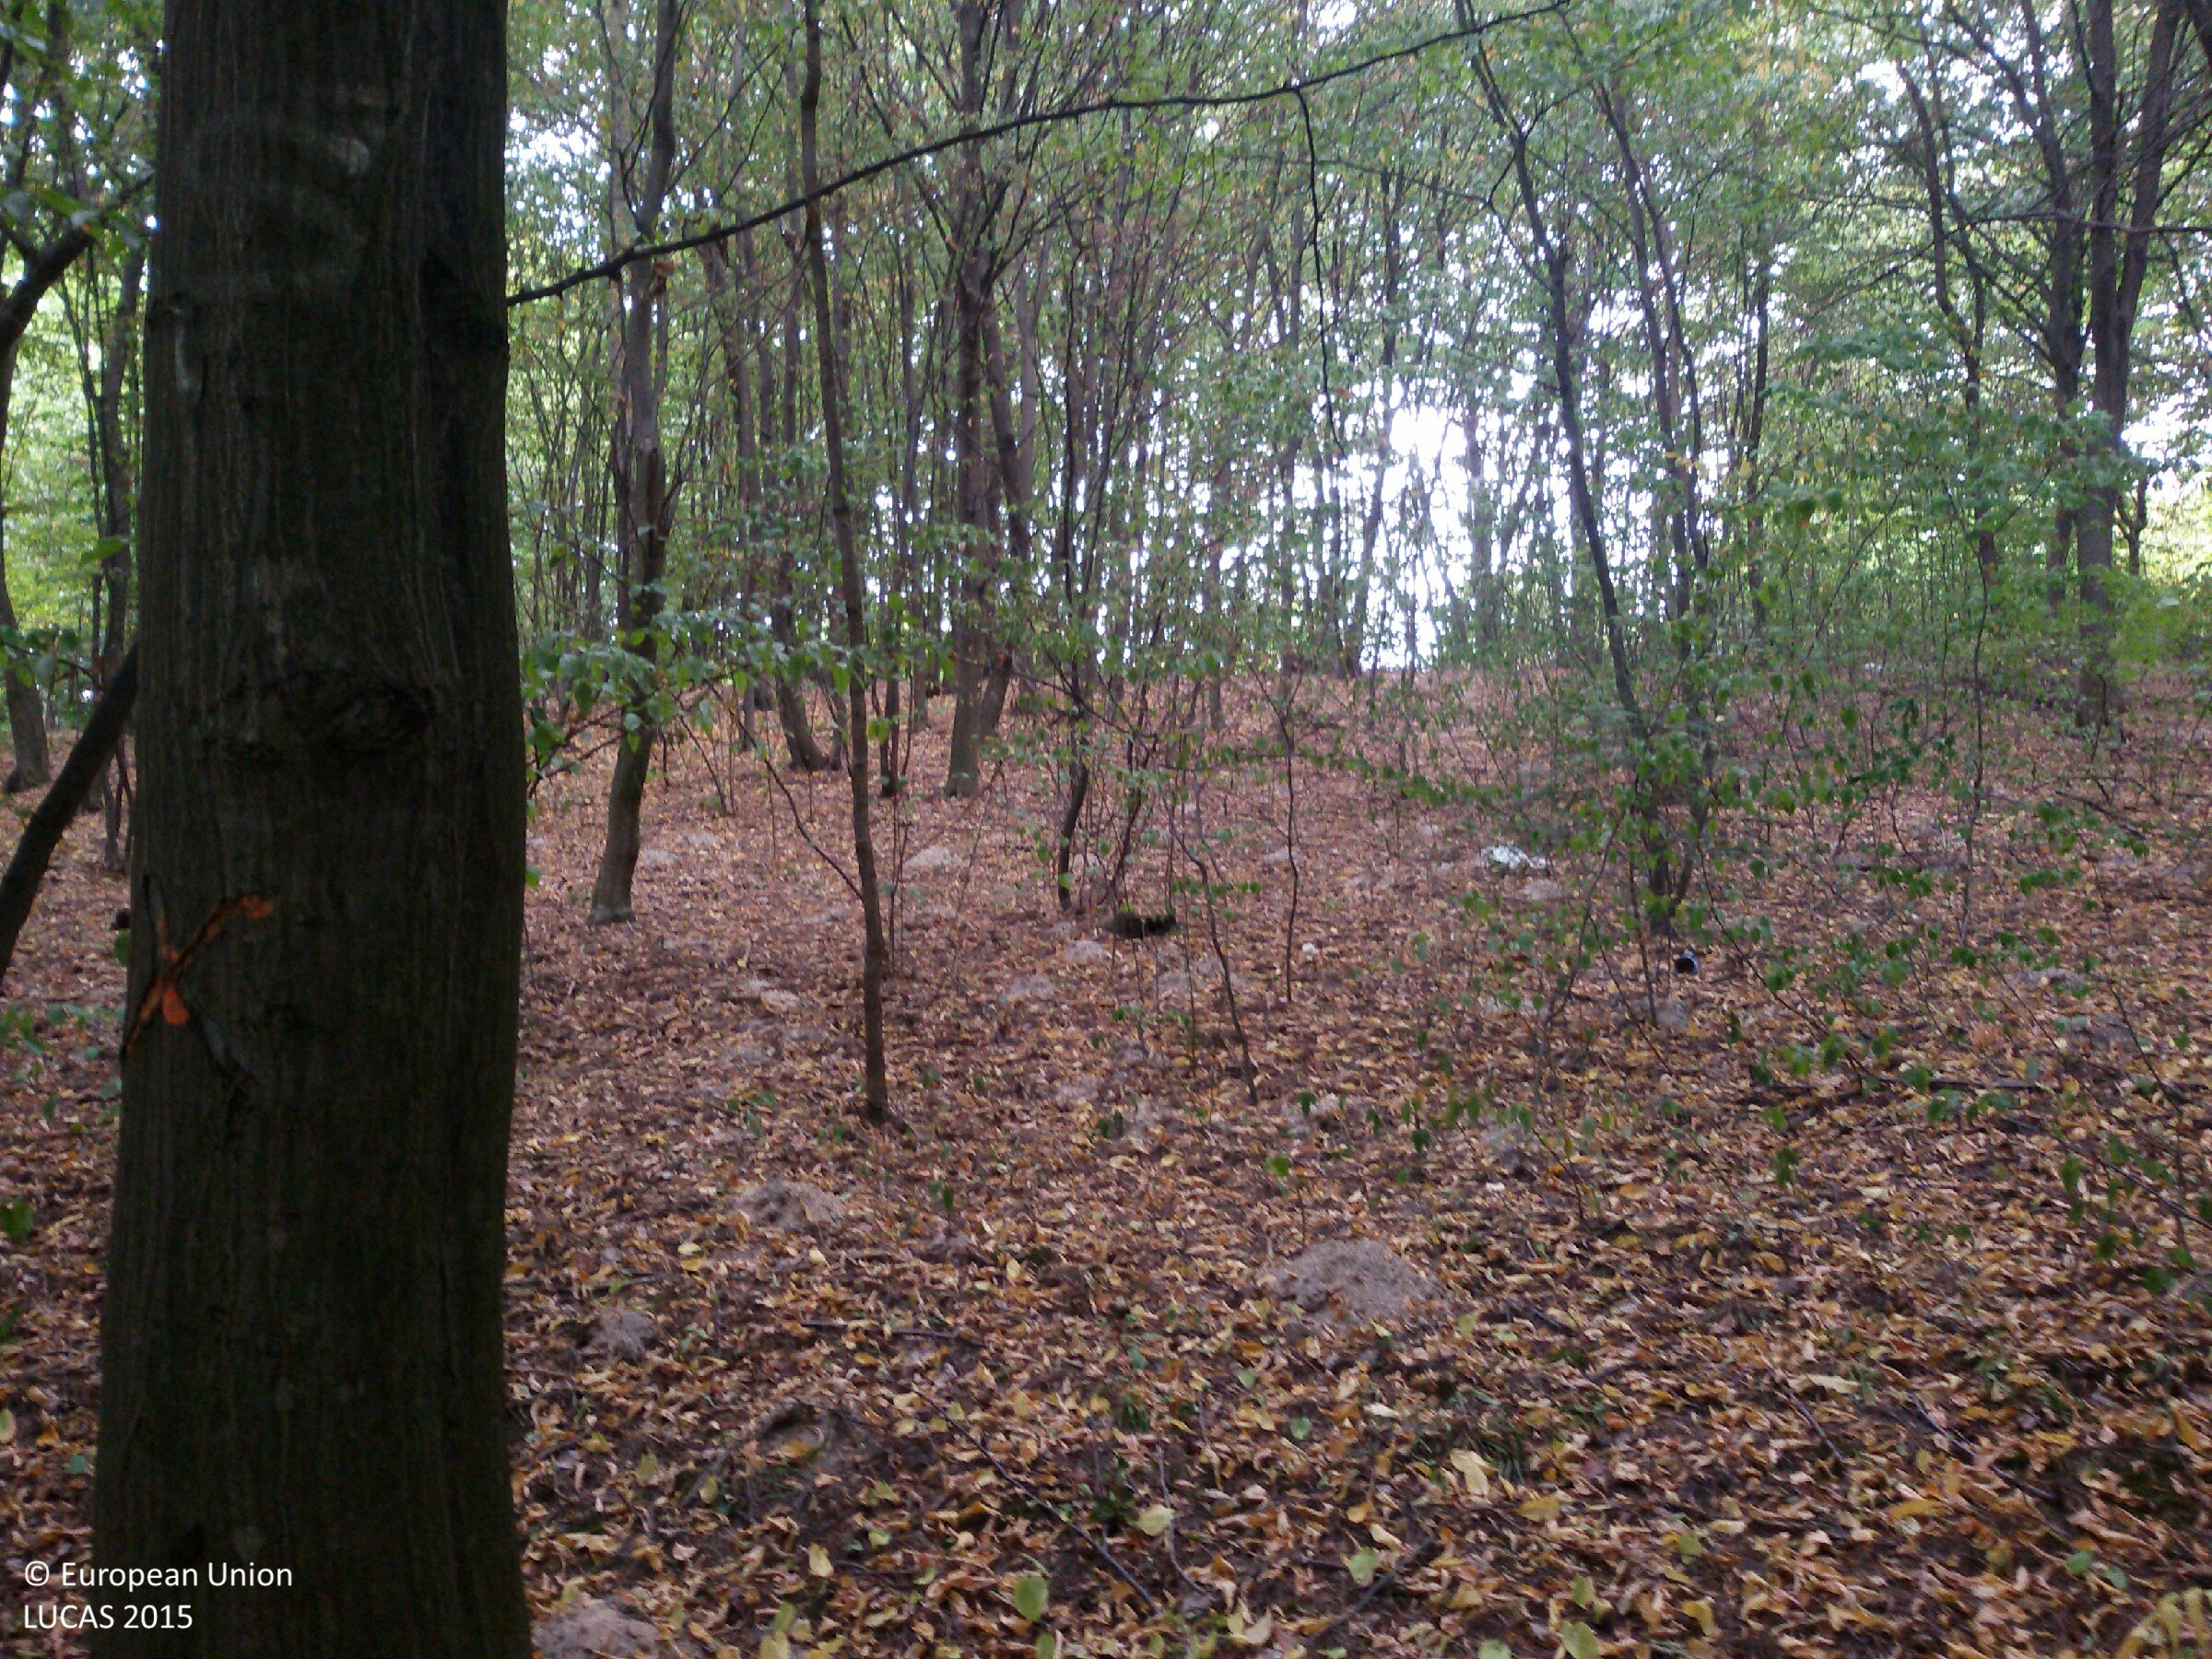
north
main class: Woodland
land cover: Broadleaved woodland
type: mesophytic deciduous forest
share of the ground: > 75 %
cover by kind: broadleaved forest trees 100 %
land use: Forestry
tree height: > 5 m
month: August
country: PL
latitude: 50.8471
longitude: 21.7435
